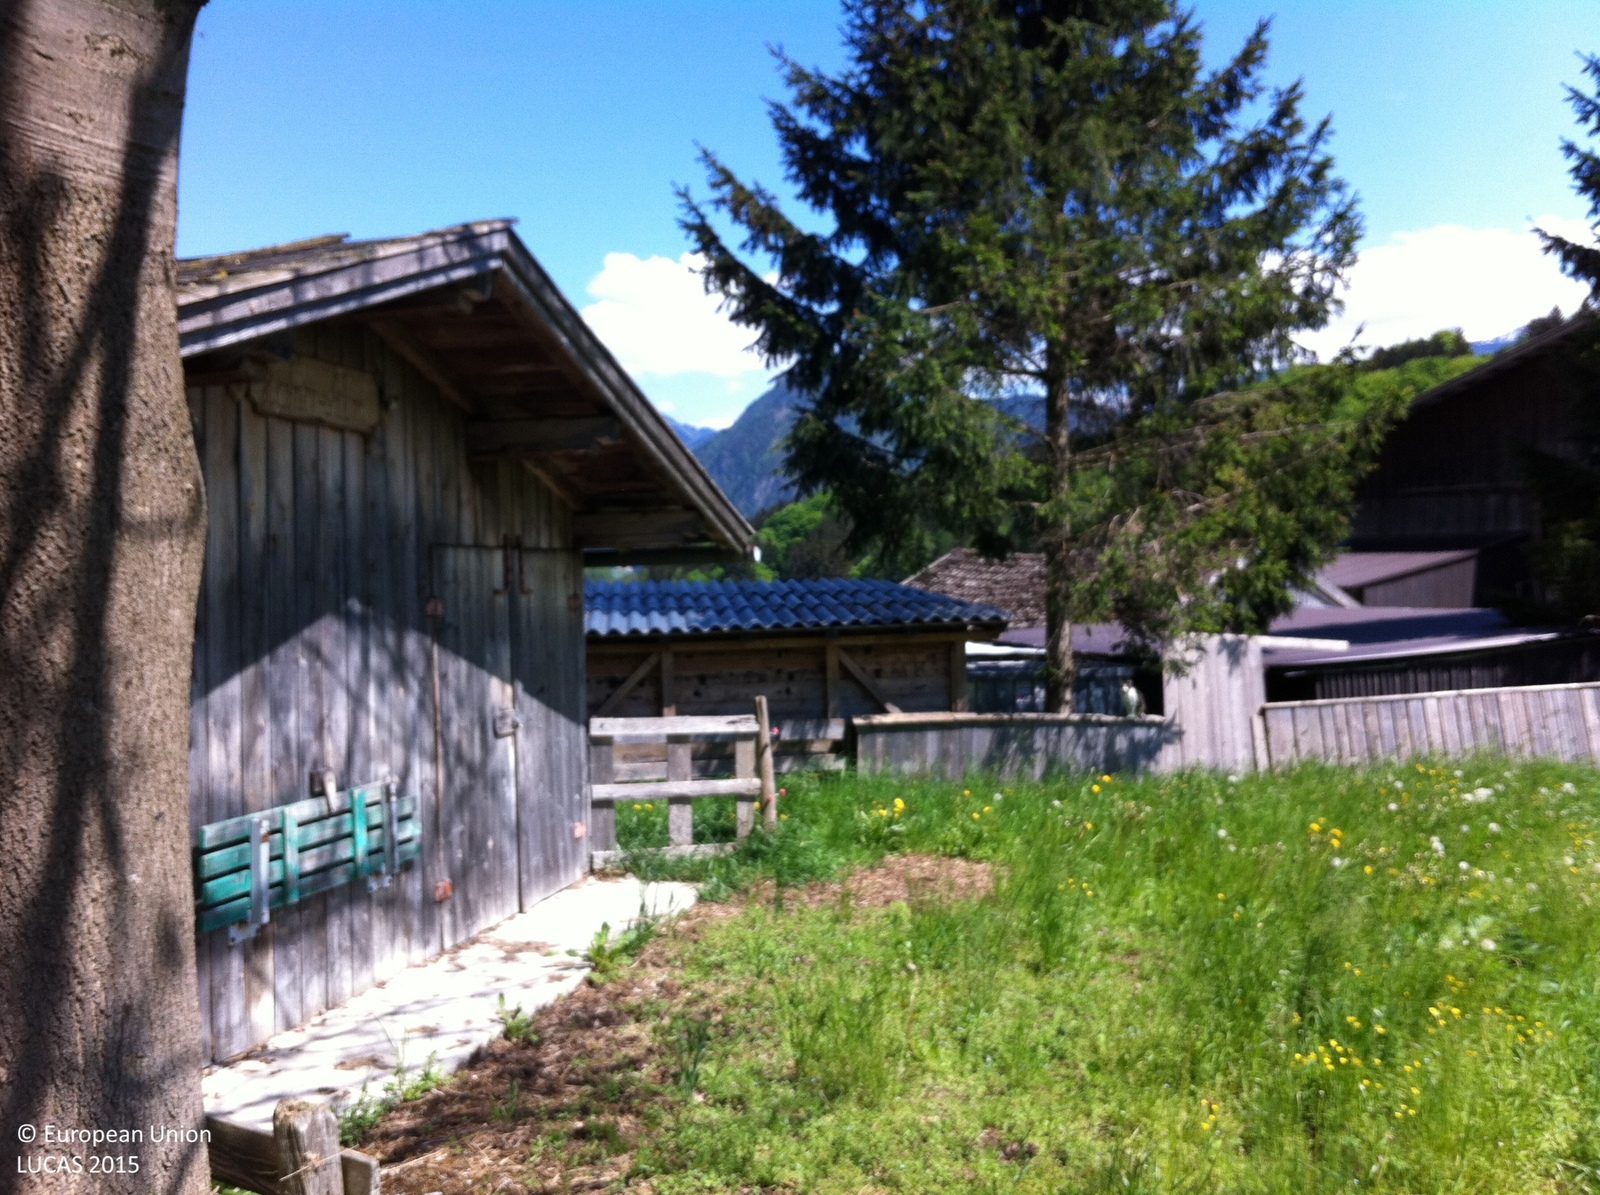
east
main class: Grassland
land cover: Grassland without tree/shrub cover
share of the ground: > 75 %
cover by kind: herbaceous plants 100 %
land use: Agriculture (excluding fallow land and kitchen gardens)
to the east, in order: Grassland without tree/shrub cover; Other mixed woodland; Artificial constructions in urban areas; Grassland without tree/shrub cover; Paved roads, cycling and walking lanes; Grassland without tree/shrub cover; Paved roads, cycling and walking lanes; Grassland without tree/shrub cover
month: May
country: AT
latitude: 47.3989
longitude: 11.7873
